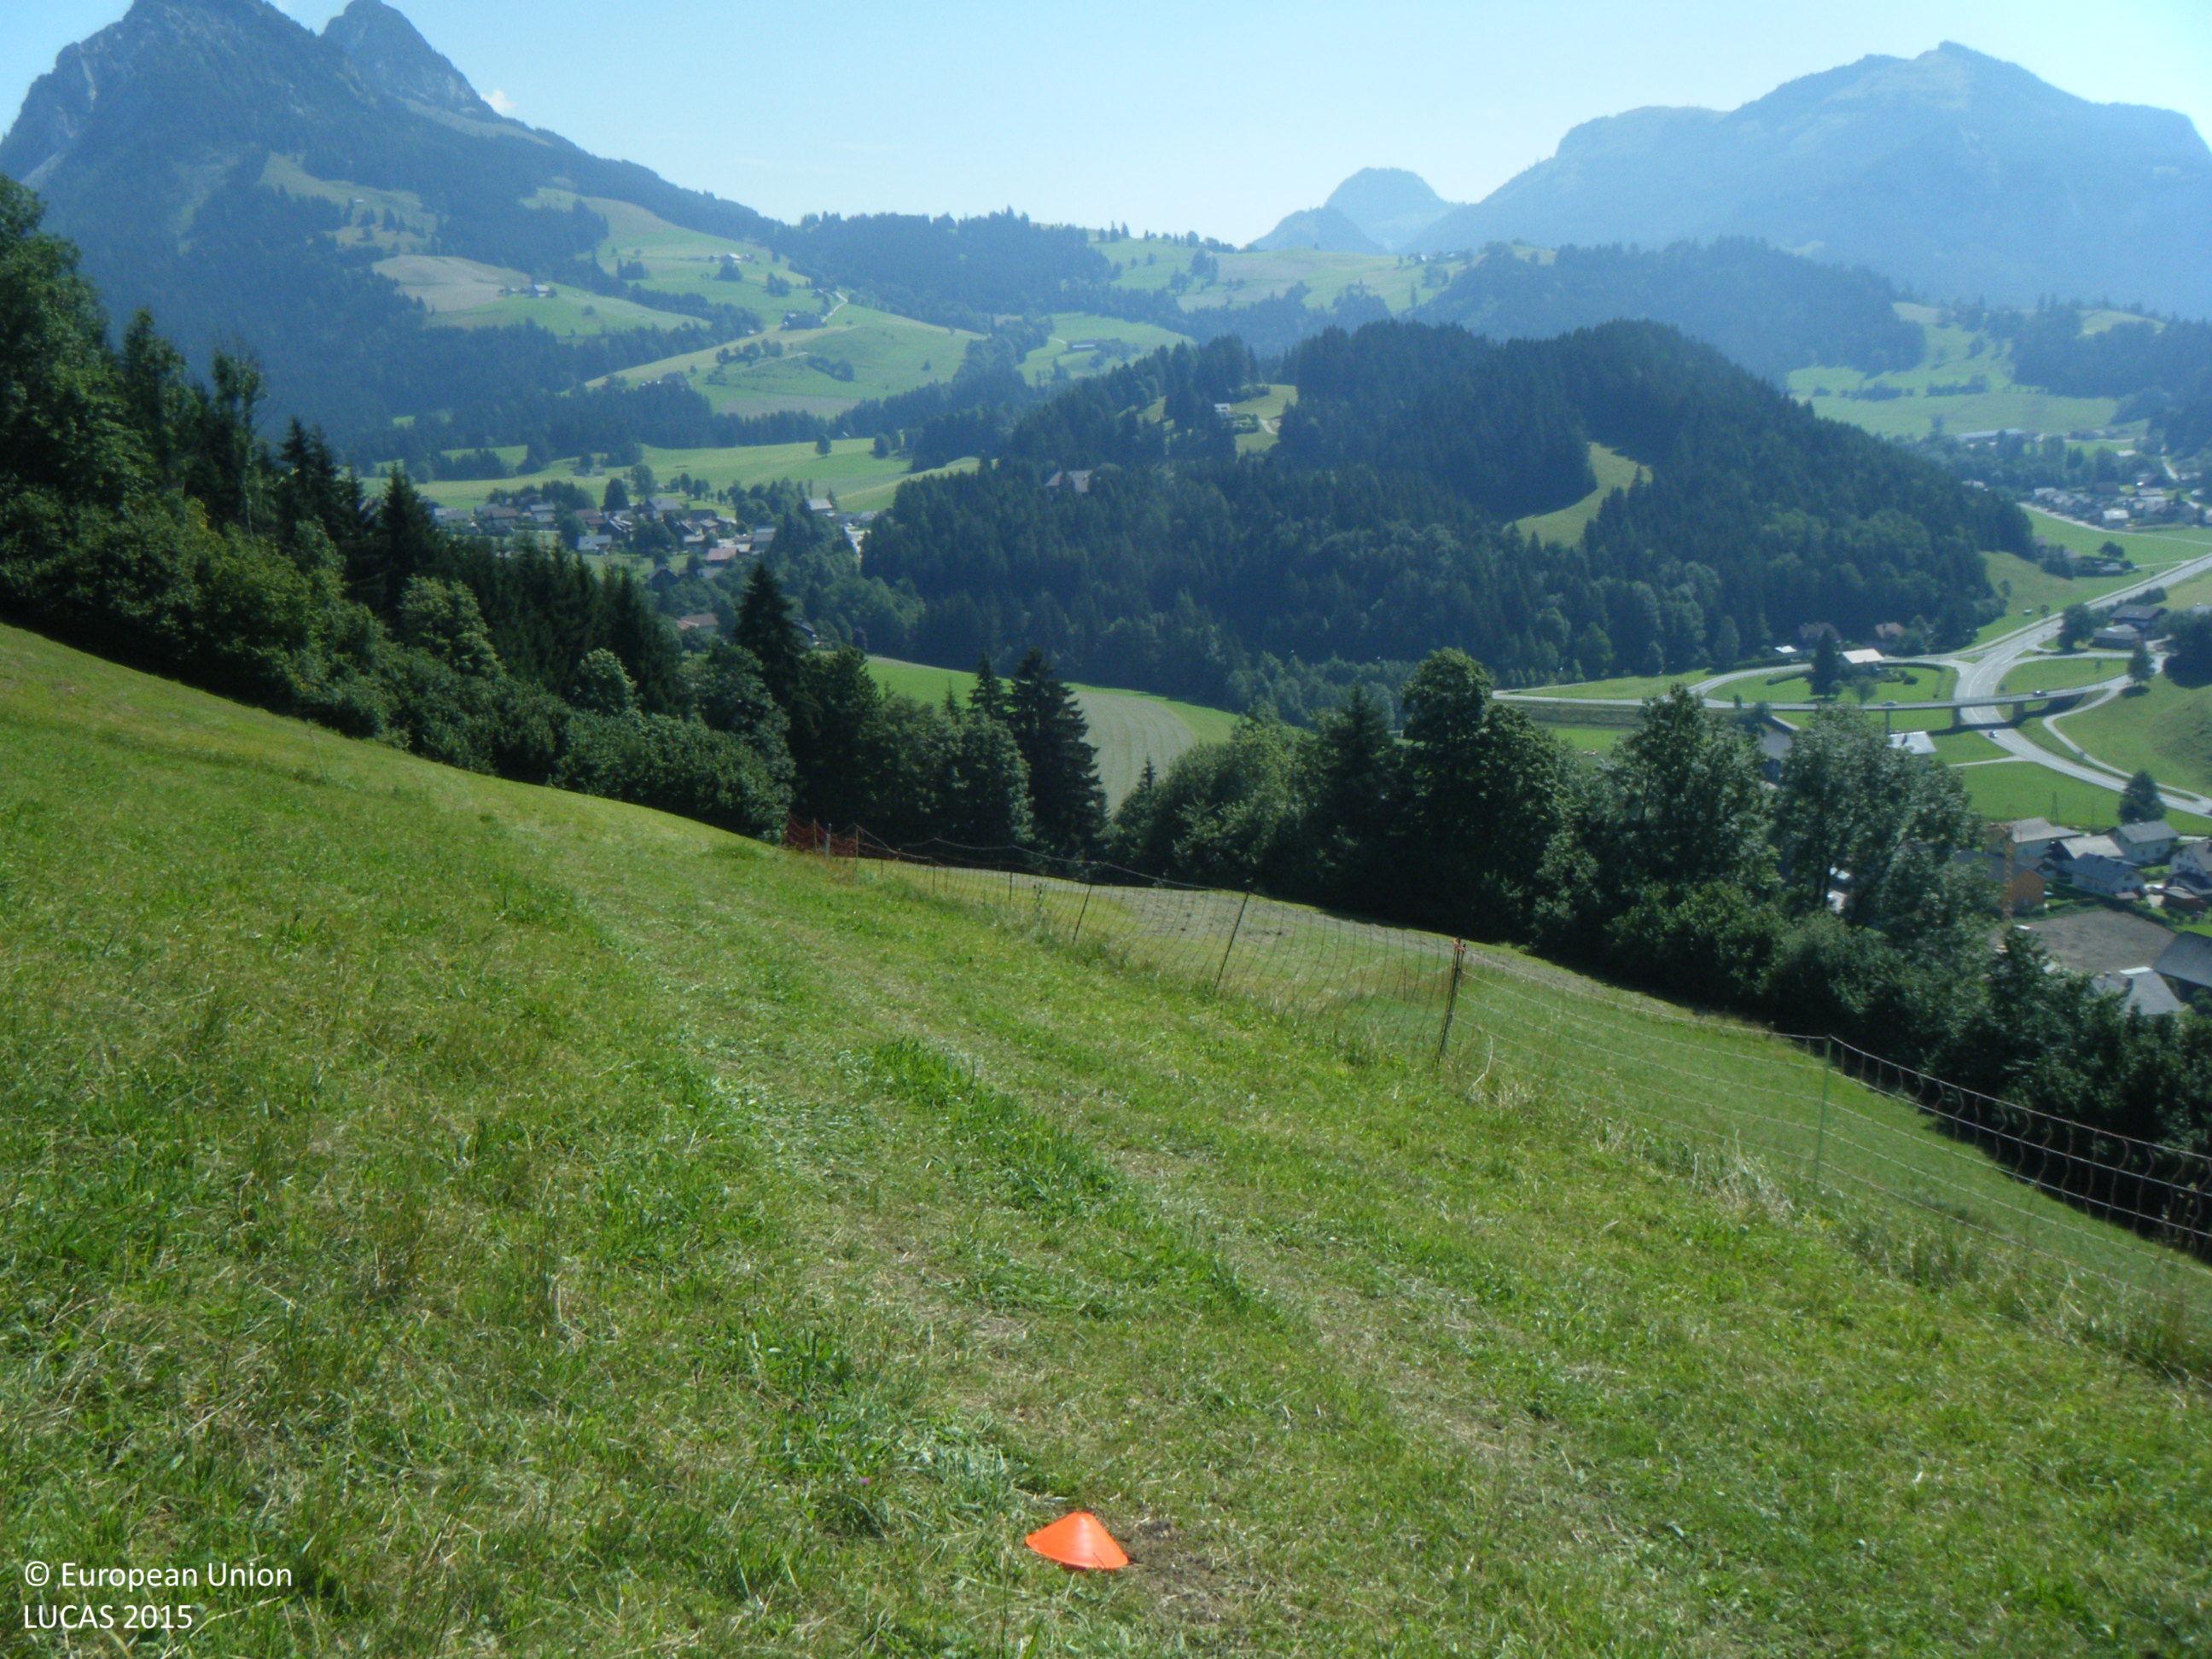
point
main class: Grassland
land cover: Grassland without tree/shrub cover
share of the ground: > 75 %
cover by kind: herbaceous plants 100 %
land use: Agriculture (excluding fallow land and kitchen gardens)
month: August
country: AT
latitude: 47.5564
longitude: 13.9989
